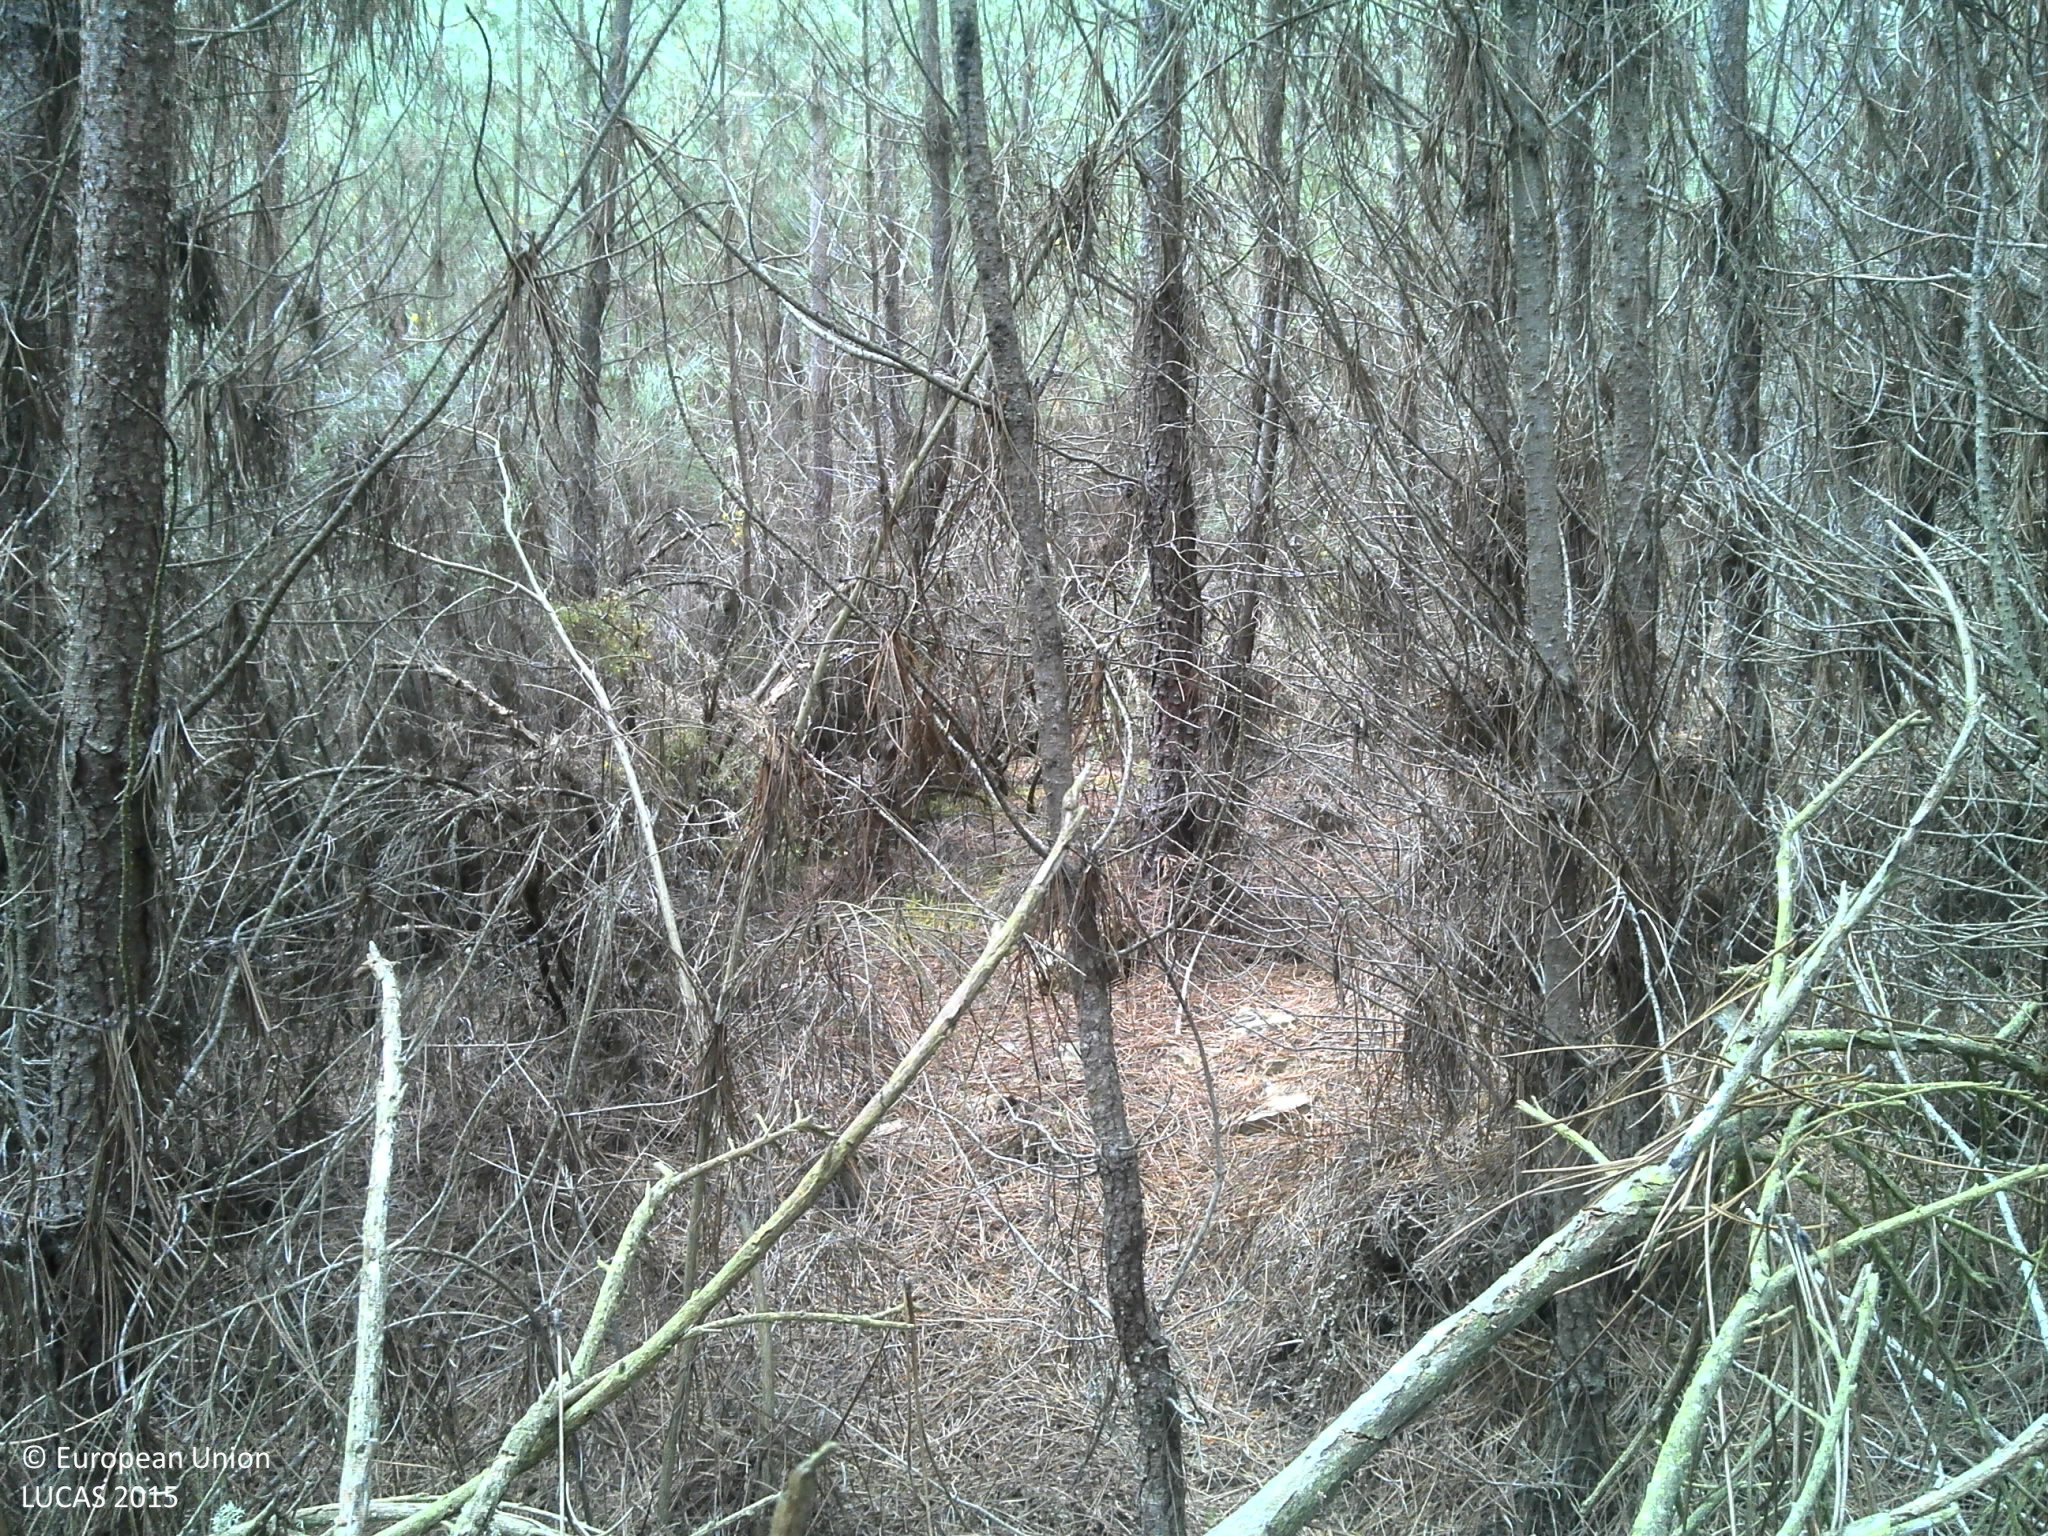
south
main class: Woodland
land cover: Pine dominated coniferous woodland
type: coniferous forest of the mediterranean region
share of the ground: > 75 %
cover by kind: coniferous forest trees 90 %, unconsolidated bare surface 10 %
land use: Forestry
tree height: > 5 m
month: May
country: PT
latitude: 41.6353
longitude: -6.9579
